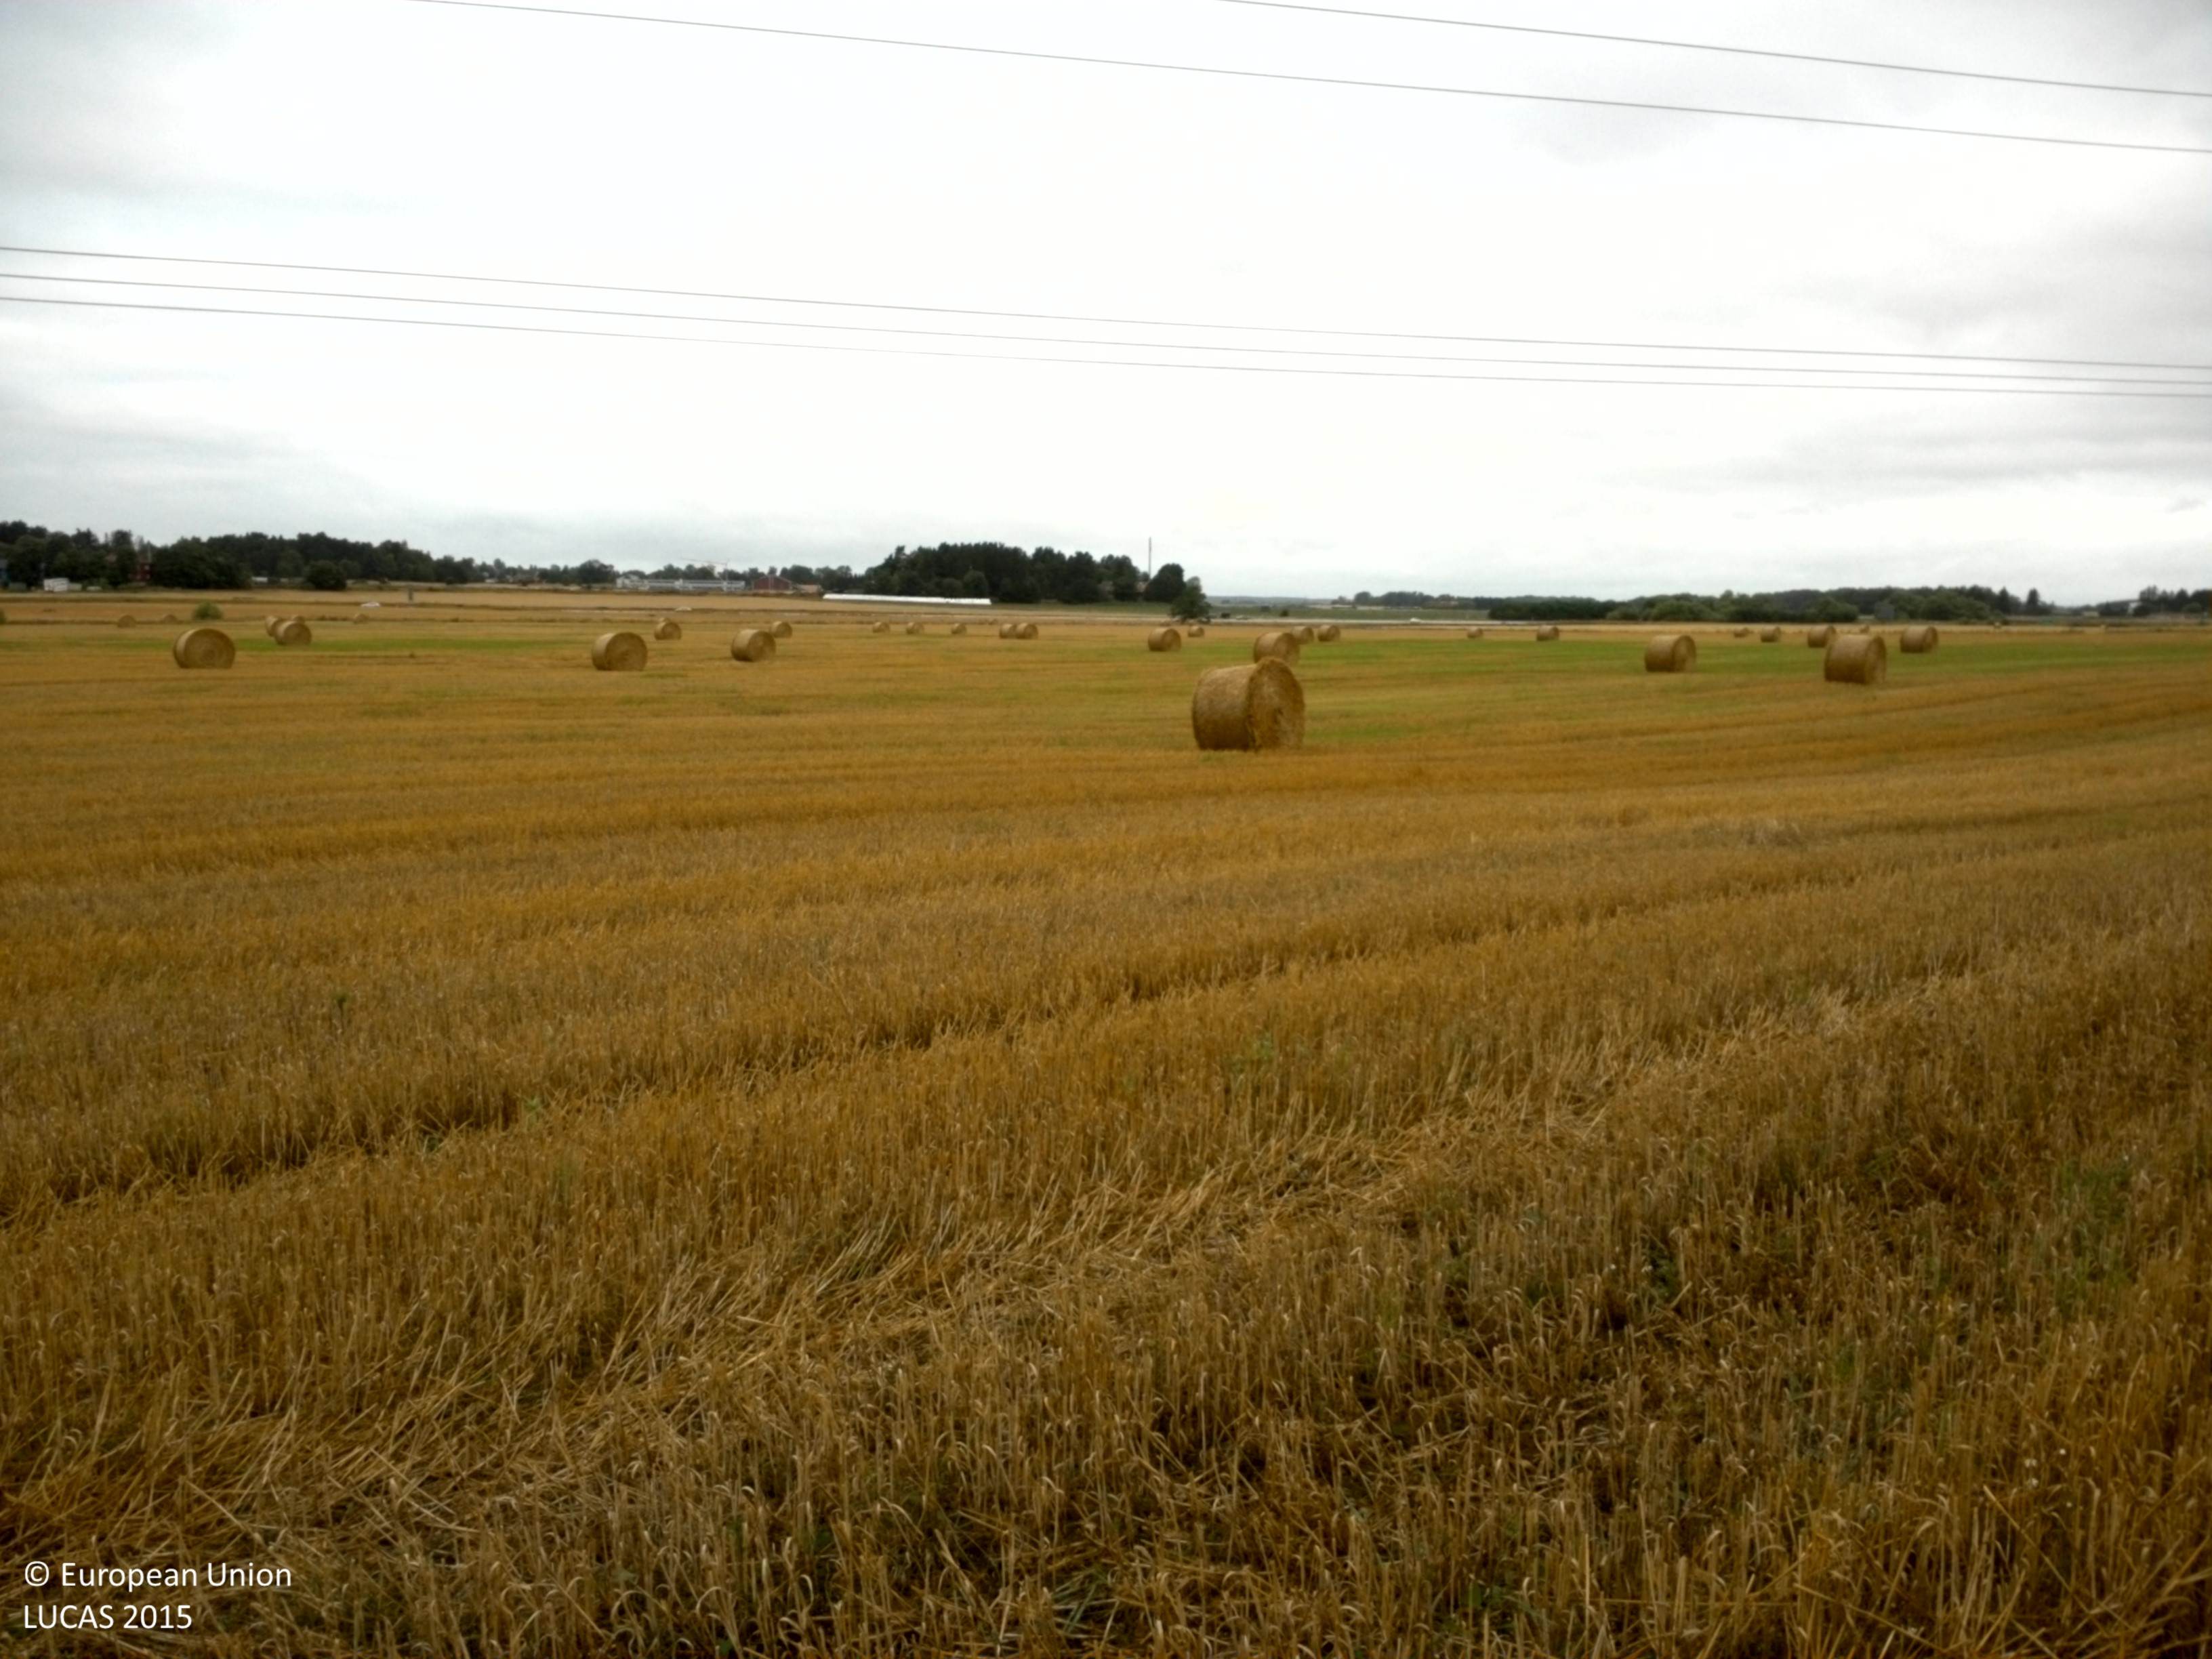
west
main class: Cropland
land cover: Common wheat
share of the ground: 10 - 25 %
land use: Agriculture (excluding fallow land and kitchen gardens)
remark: Harvested field
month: August
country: SE
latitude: 59.8998
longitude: 17.6631
